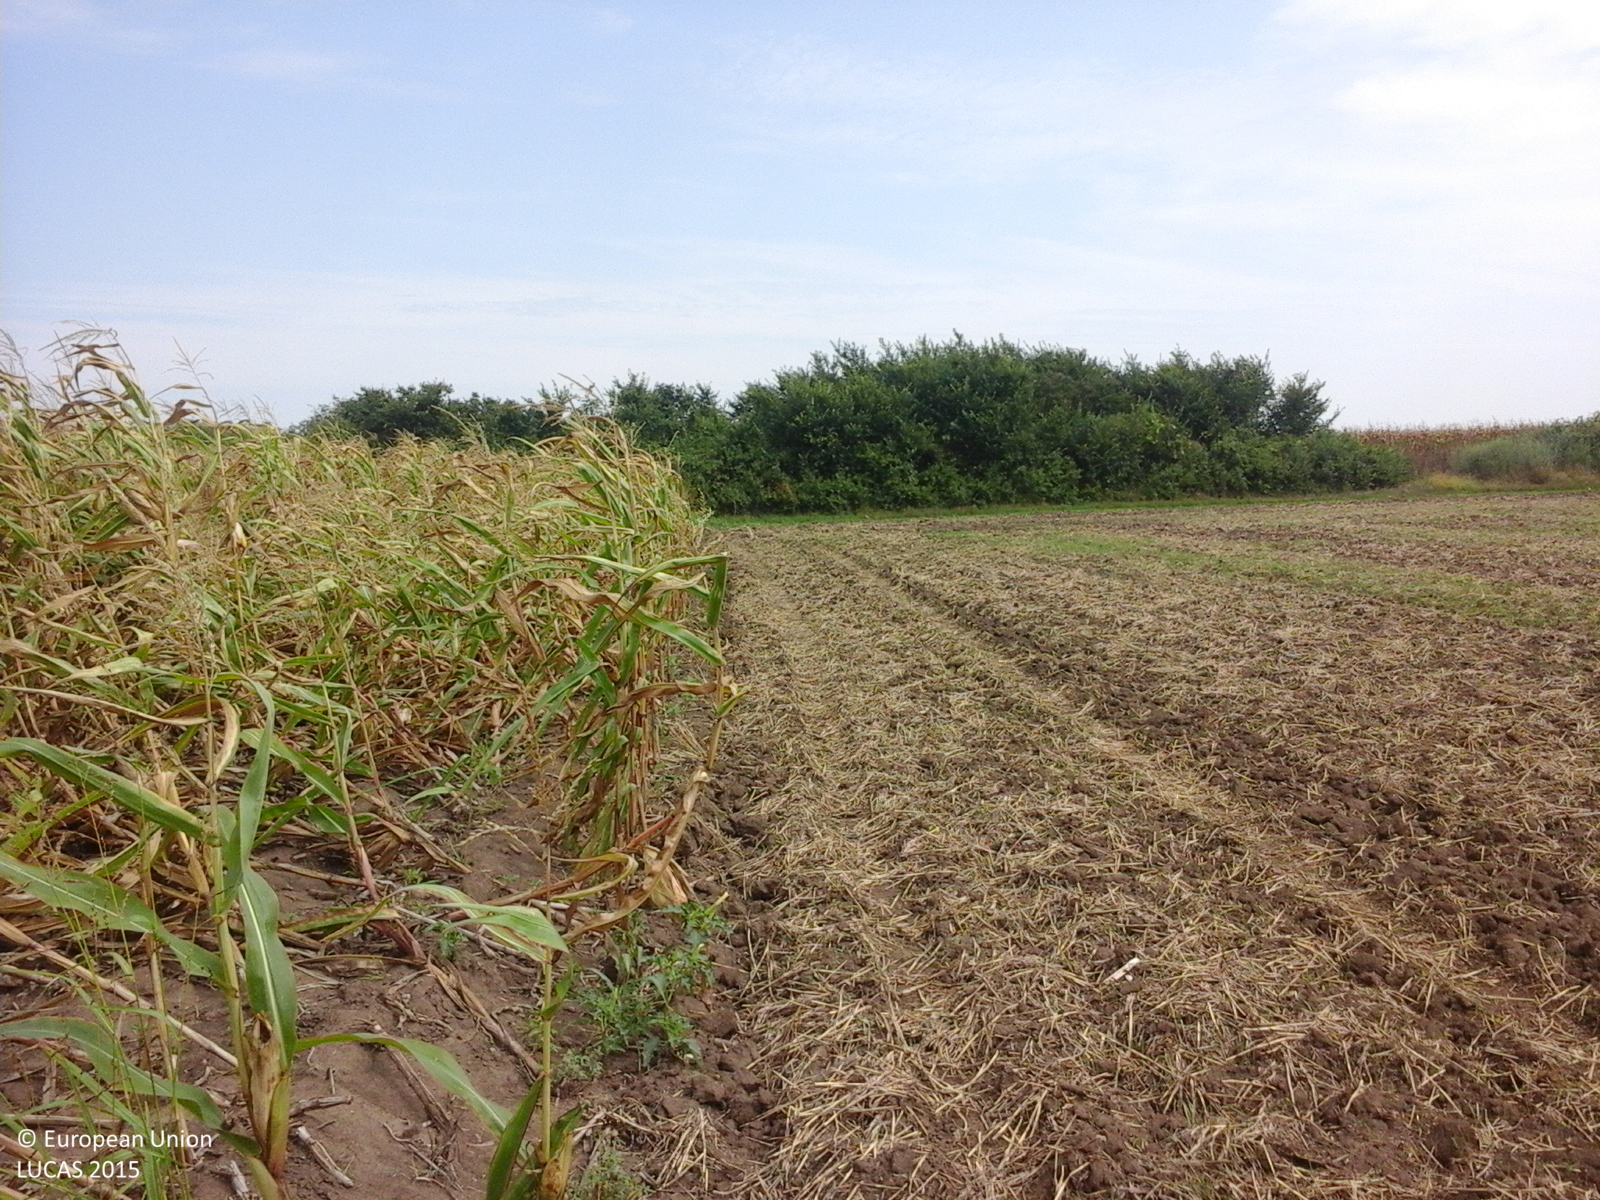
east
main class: Cropland
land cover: Maize
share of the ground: > 75 %
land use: Agriculture (excluding fallow land and kitchen gardens)
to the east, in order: Maize; Grass margins; Tracks; Grass margins; Shrubland with sparse tree cover; Grass margins; Maize; Spontaneously vegetated surfaces; Sunflower
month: August
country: RO
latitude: 46.2303
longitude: 20.8820
